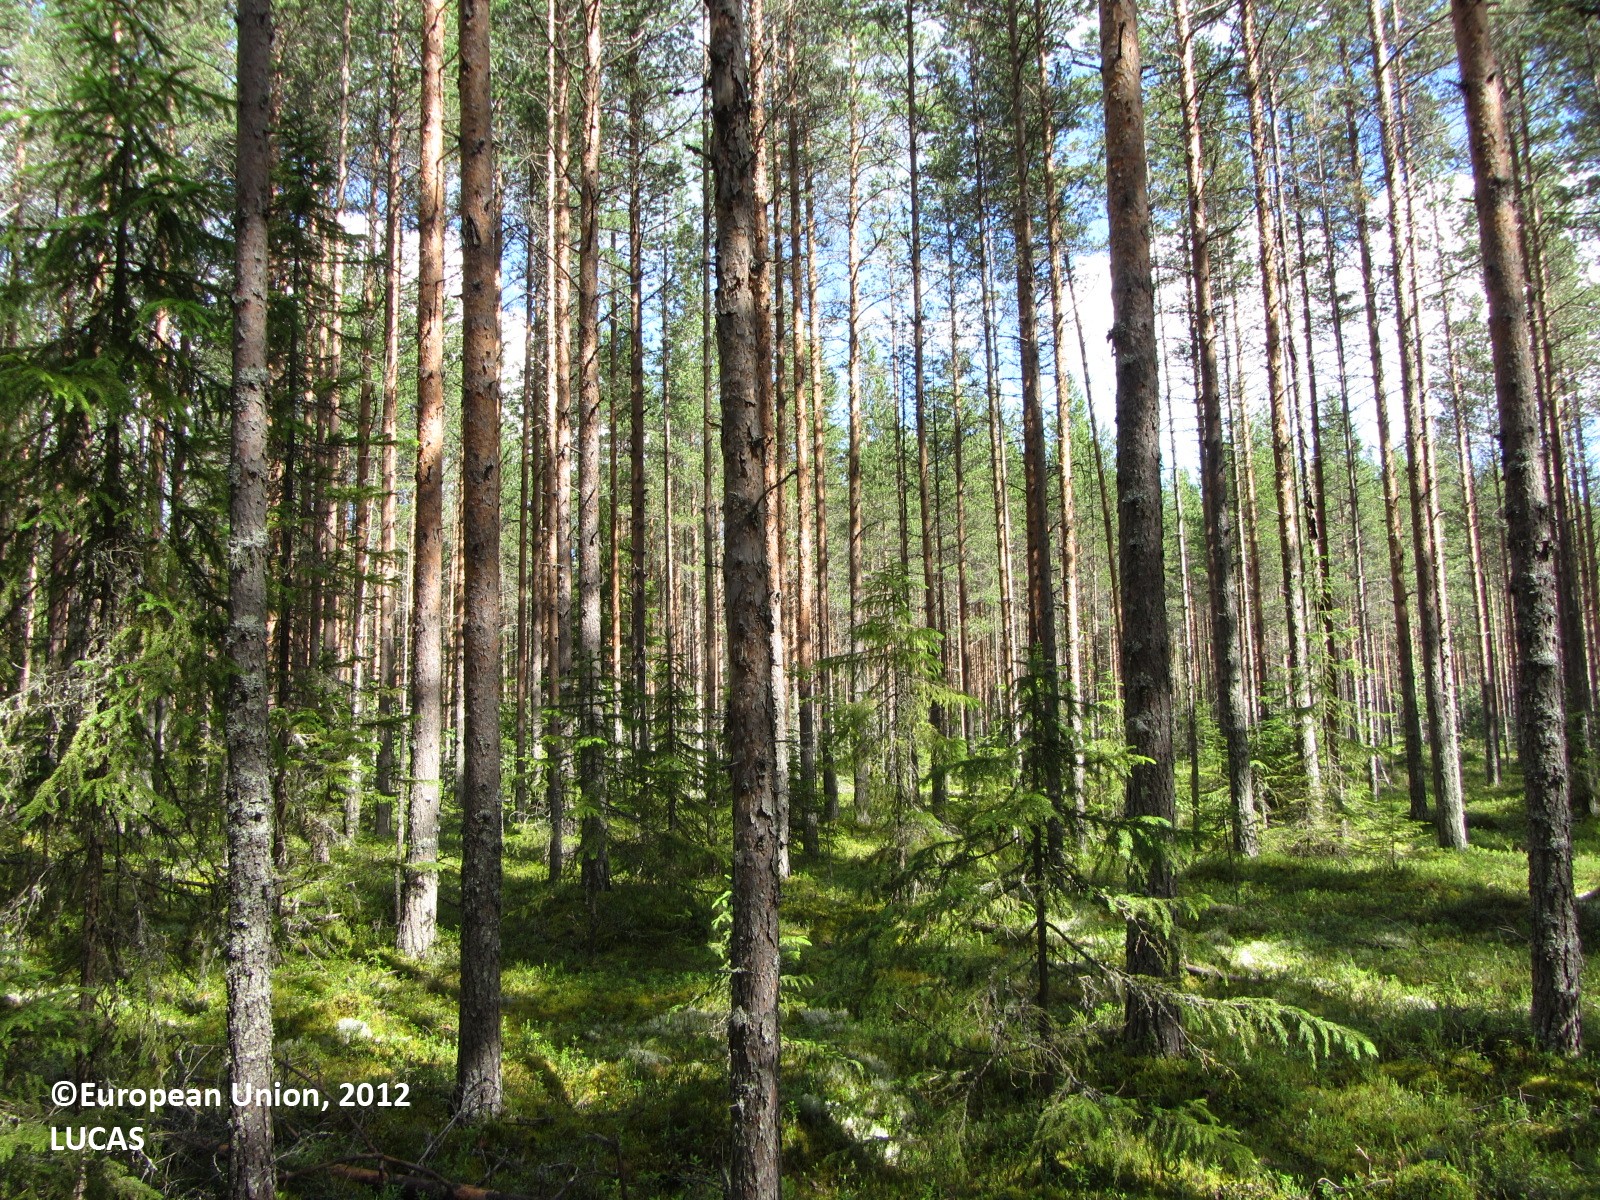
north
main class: Woodland
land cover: Pine dominated coniferous woodland
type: boreal forest
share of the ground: 50 - 75 %
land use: Forestry
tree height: > 5 m
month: July
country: FI
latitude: 63.6436
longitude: 25.5456
